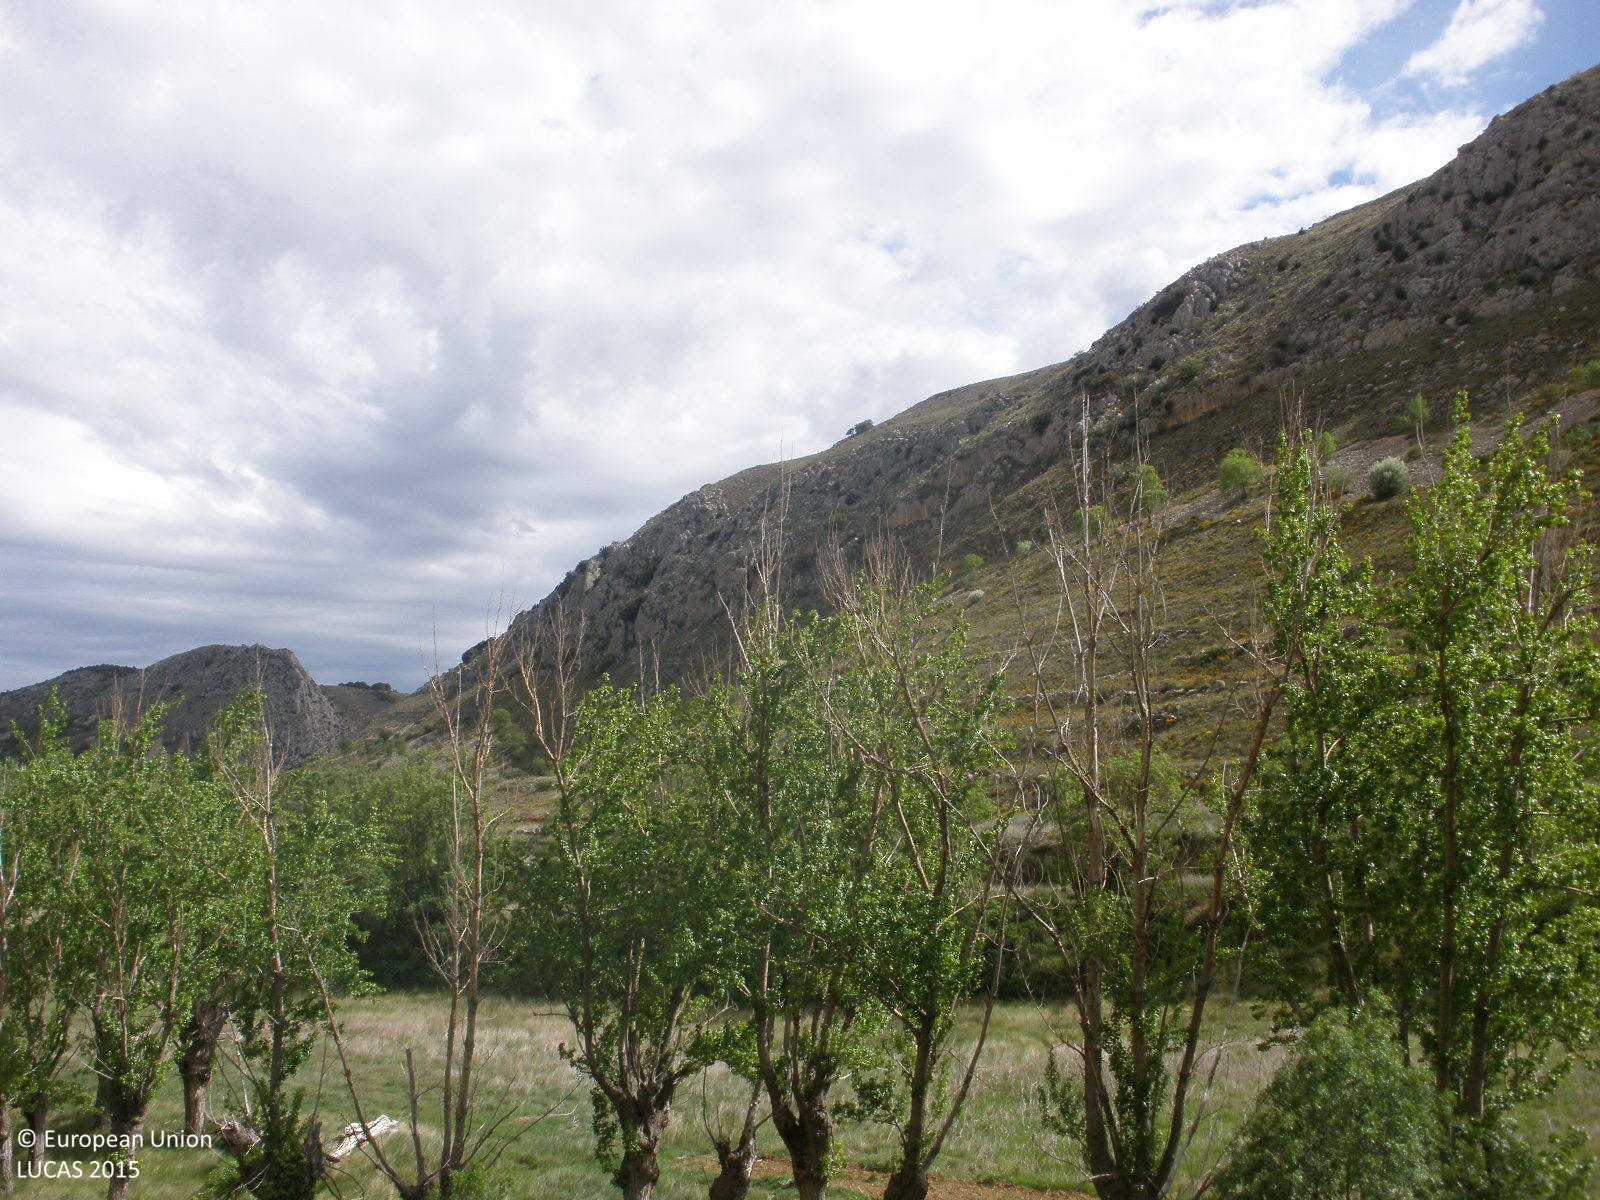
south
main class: Shrubland
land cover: Shrubland without tree cover
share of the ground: > 75 %
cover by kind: shrubs 70 %, herbaceous plants 15 %, consolidated bare surface 15 %
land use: Semi-natural and natural areas not in use
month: May
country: ES
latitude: 41.0054
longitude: -0.9186
